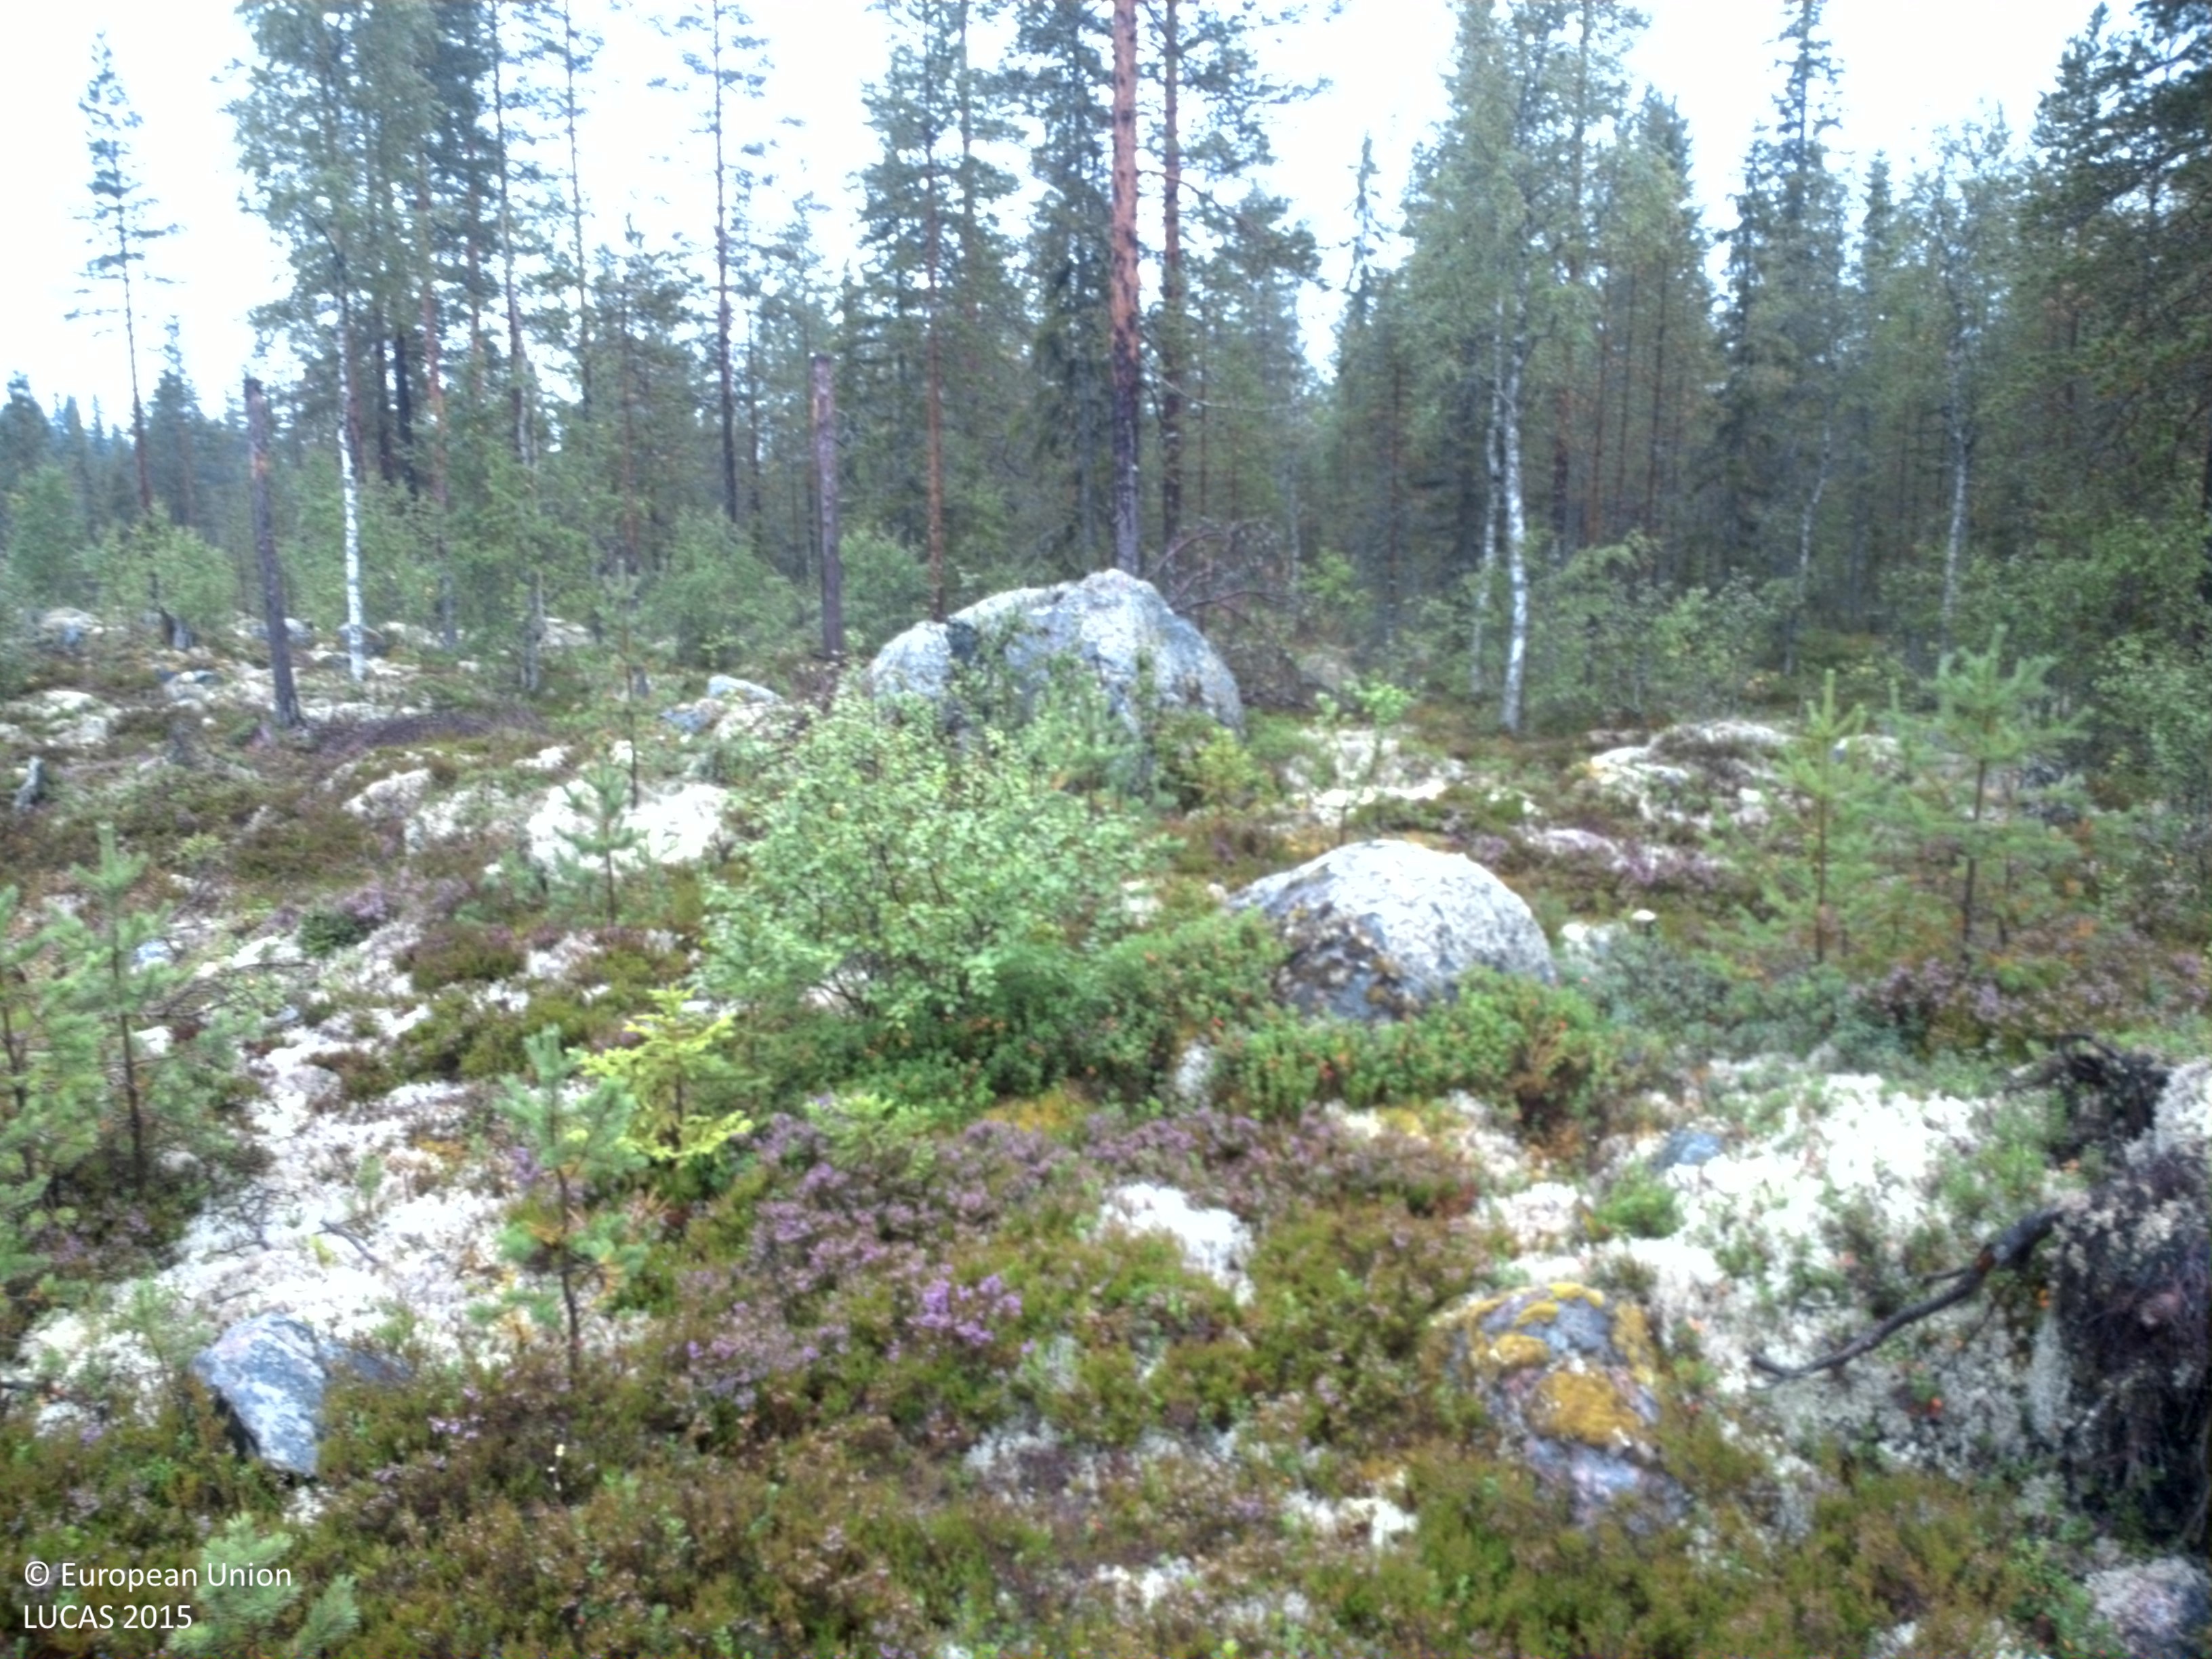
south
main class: Woodland
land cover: Pine dominated coniferous woodland
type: boreal forest
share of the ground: 10 - 25 %
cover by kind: shrubs 65 %, lichens and mosses 20 %, coniferous forest trees 15 %
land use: Forestry
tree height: < 5 m
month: August
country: SE
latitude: 61.7333
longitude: 15.0374
